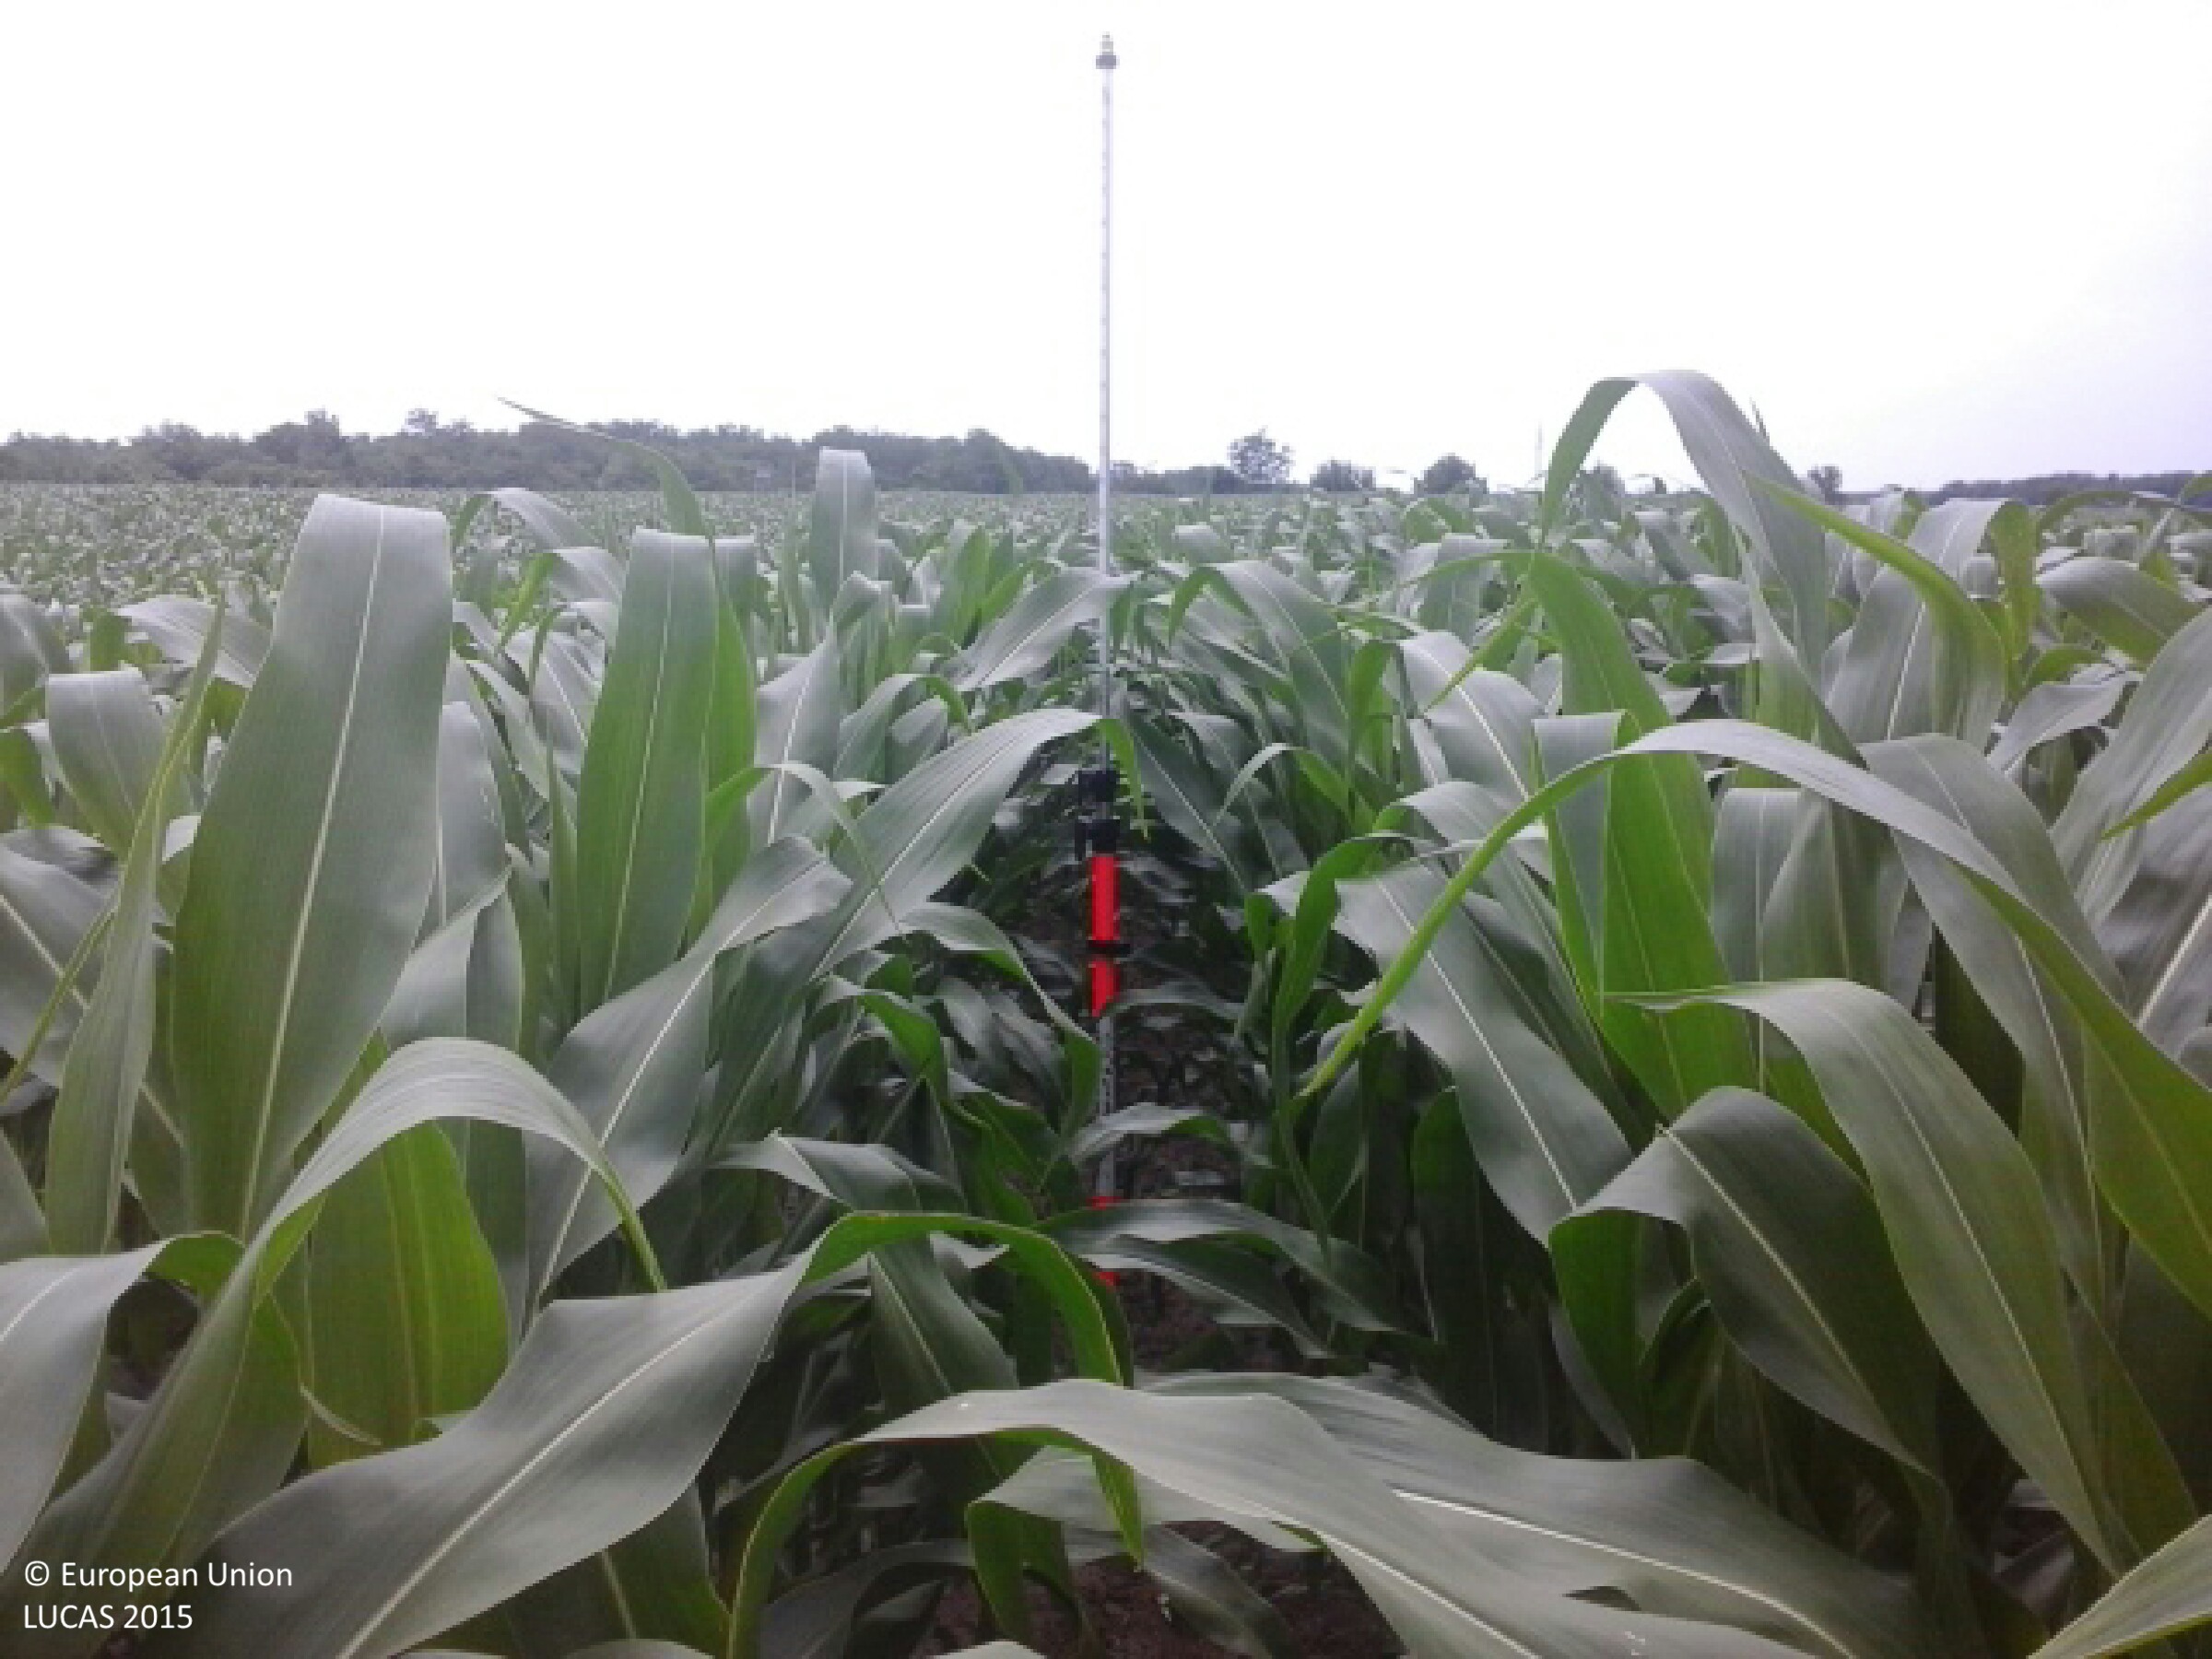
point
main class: Cropland
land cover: Maize
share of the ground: > 75 %
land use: Agriculture (excluding fallow land and kitchen gardens)
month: June
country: HU
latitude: 48.1324
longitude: 21.9707
